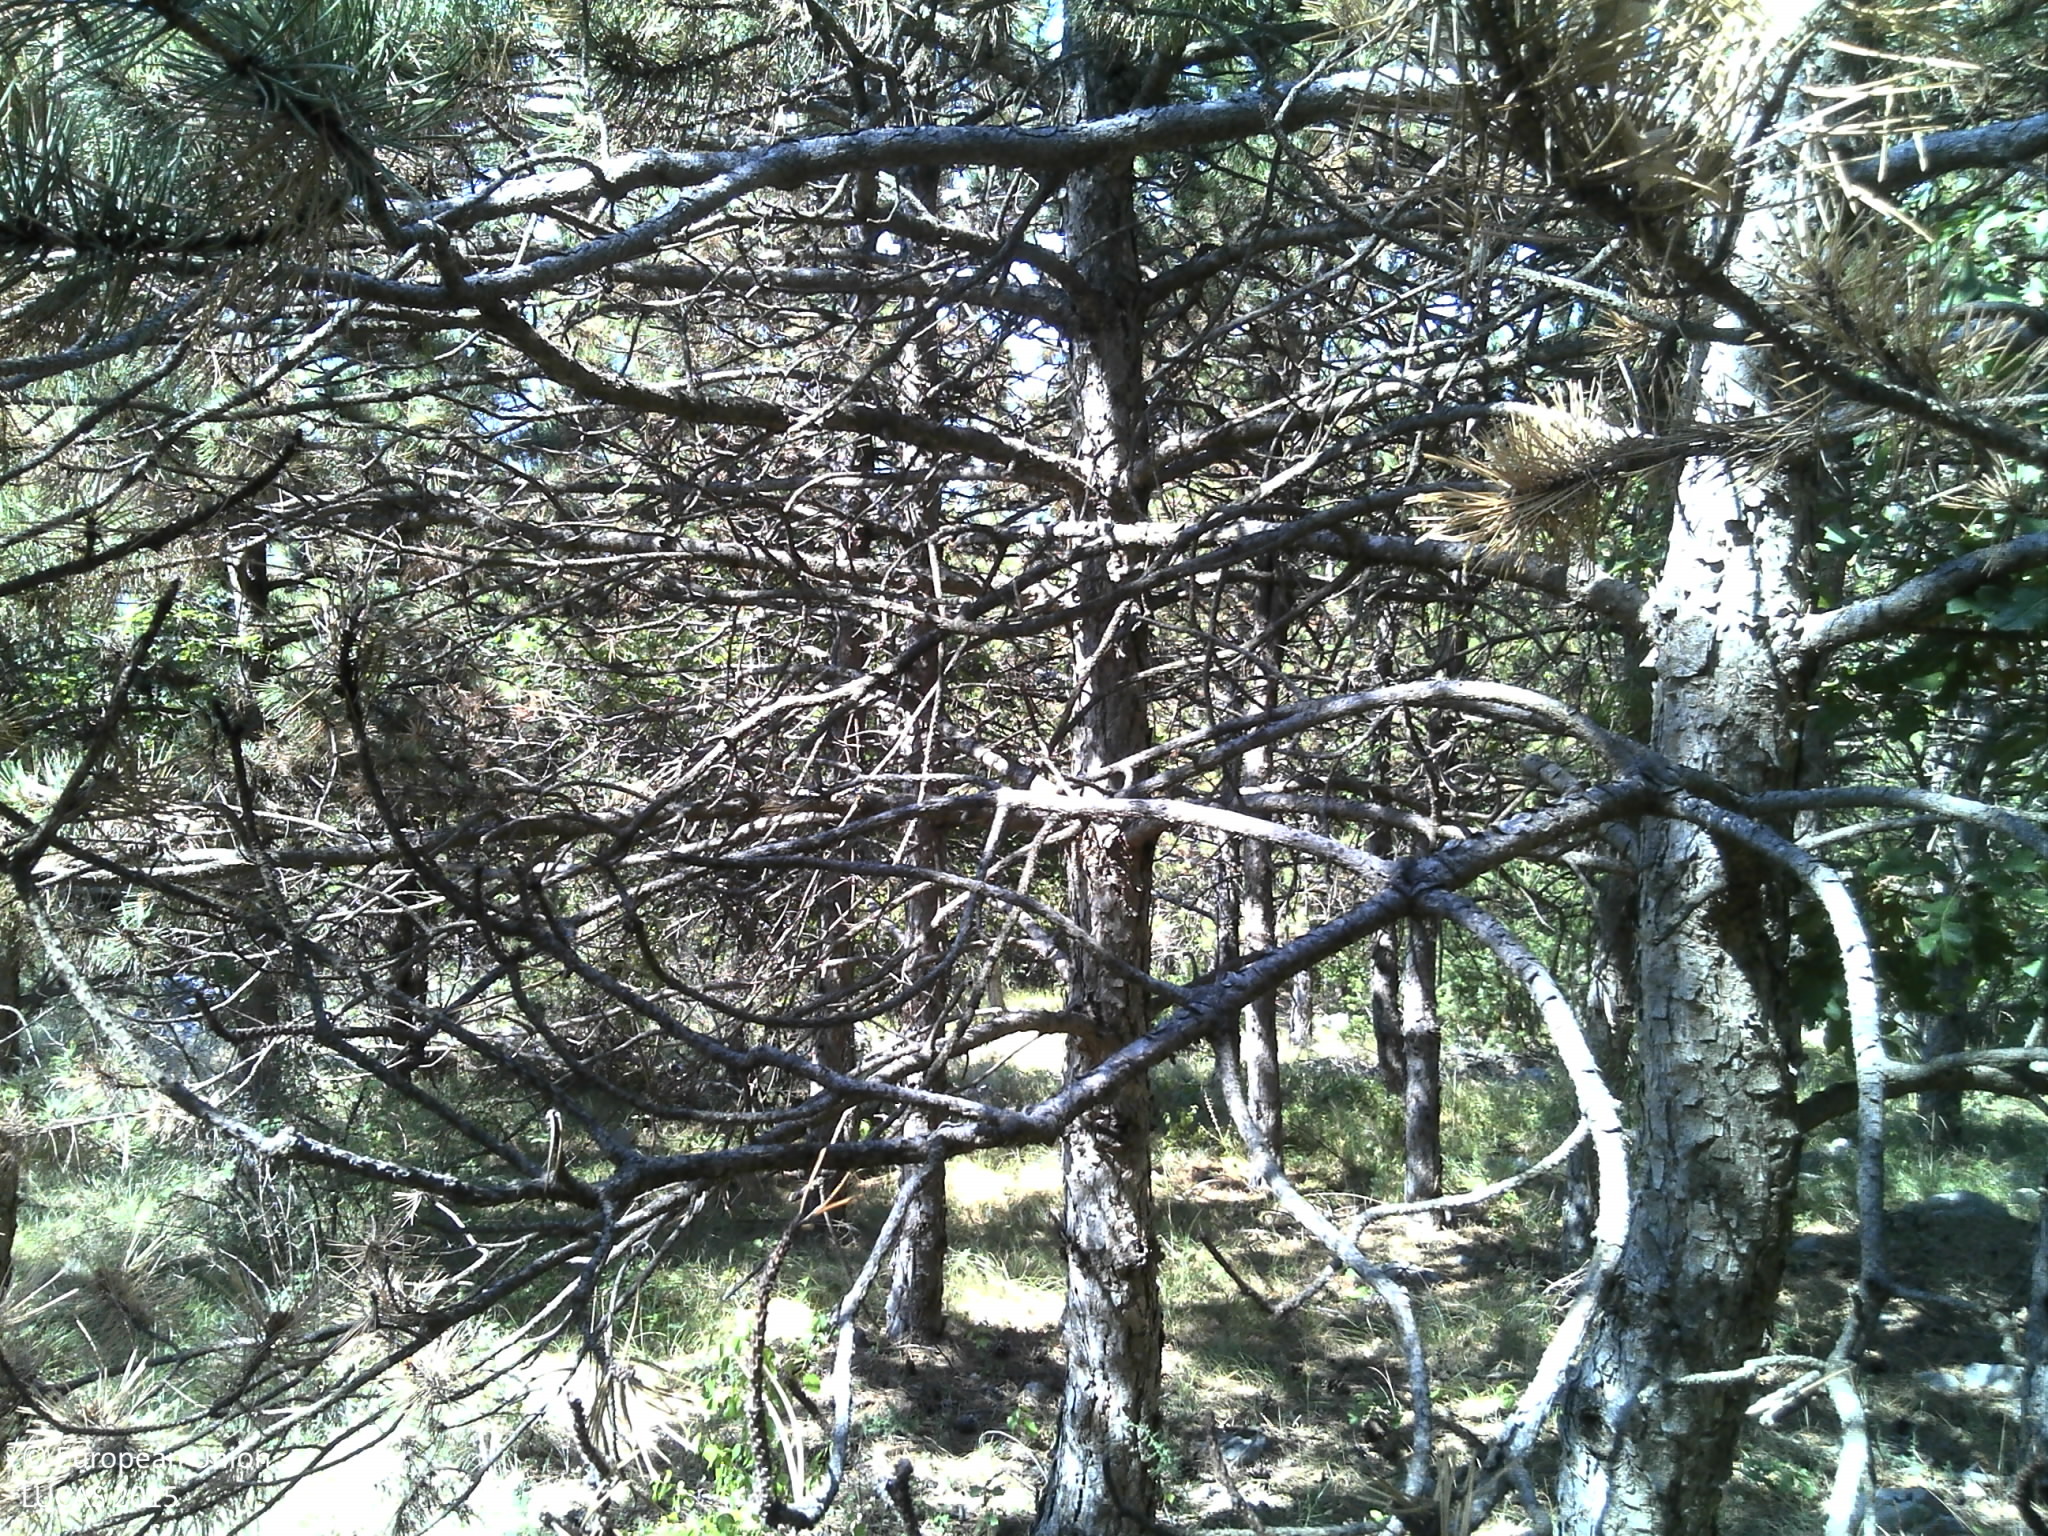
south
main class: Woodland
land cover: Pine dominated coniferous woodland
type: coniferous forest of the mediterranean region
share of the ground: > 75 %
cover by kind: coniferous forest trees 80 %, shrubs 10 %, herbaceous plants 5 %, consolidated bare surface 5 %
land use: Semi-natural and natural areas not in use
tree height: > 5 m
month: July
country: HR
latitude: 43.4684
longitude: 17.1737
